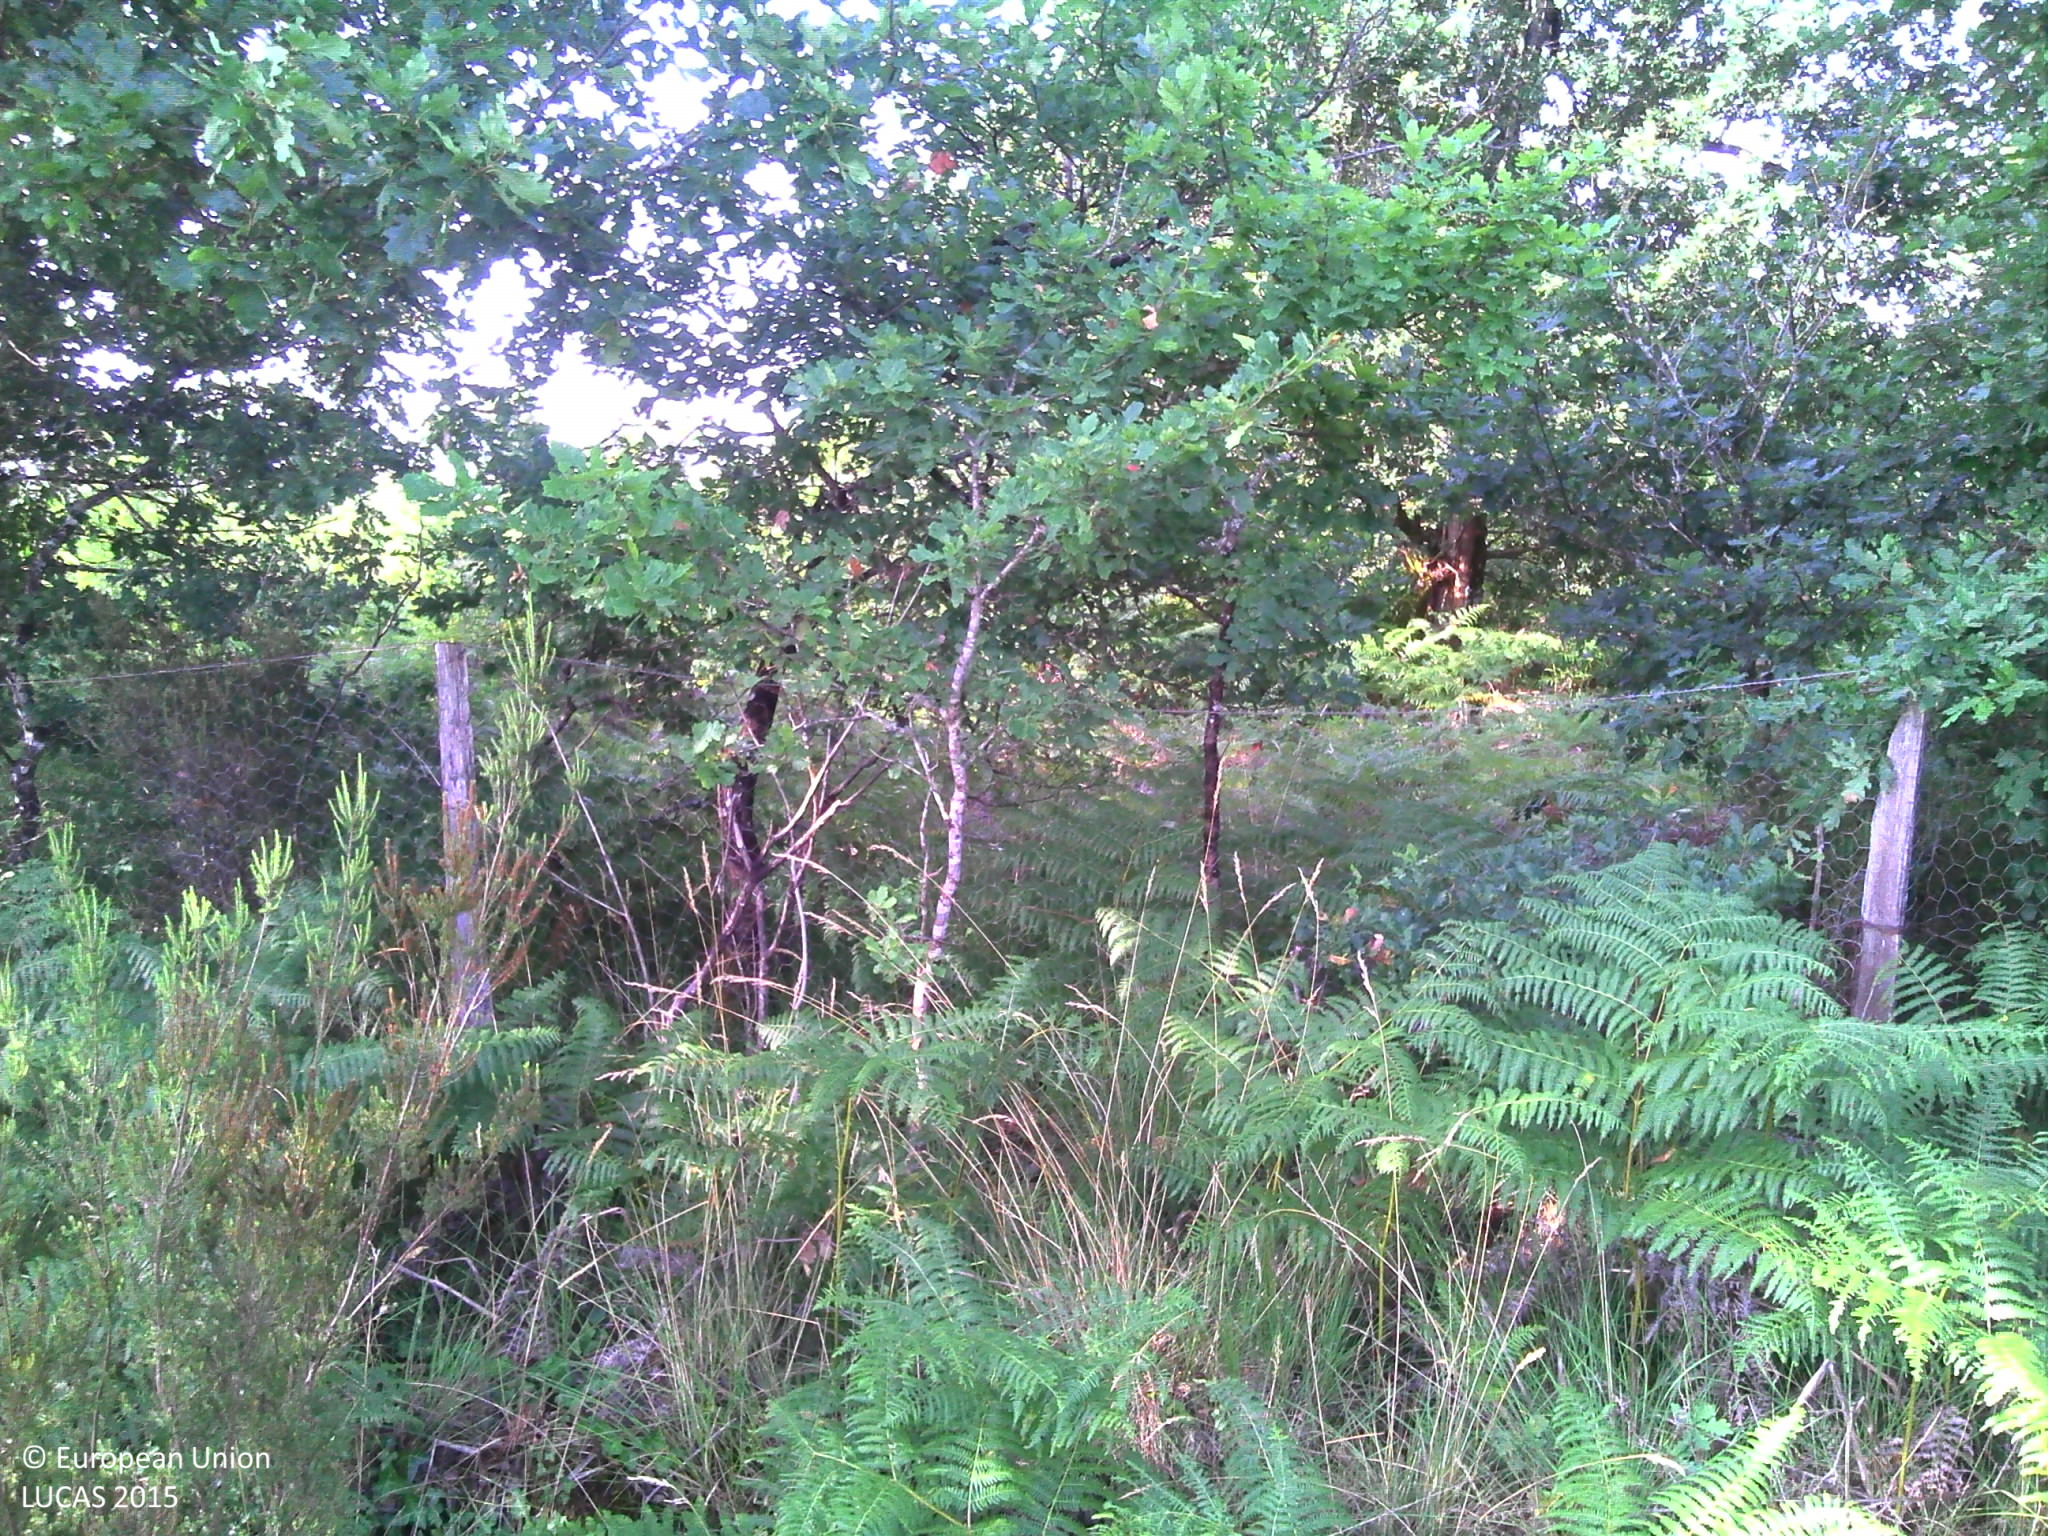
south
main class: Woodland
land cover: Broadleaved woodland
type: thermophilous deciduous forest
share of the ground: 50 - 75 %
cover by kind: broadleaved forest trees 75 %, herbaceous plants 15 %, coniferous forest trees 10 %
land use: Forestry
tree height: > 5 m
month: July
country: FR
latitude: 44.1281
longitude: -0.6504
